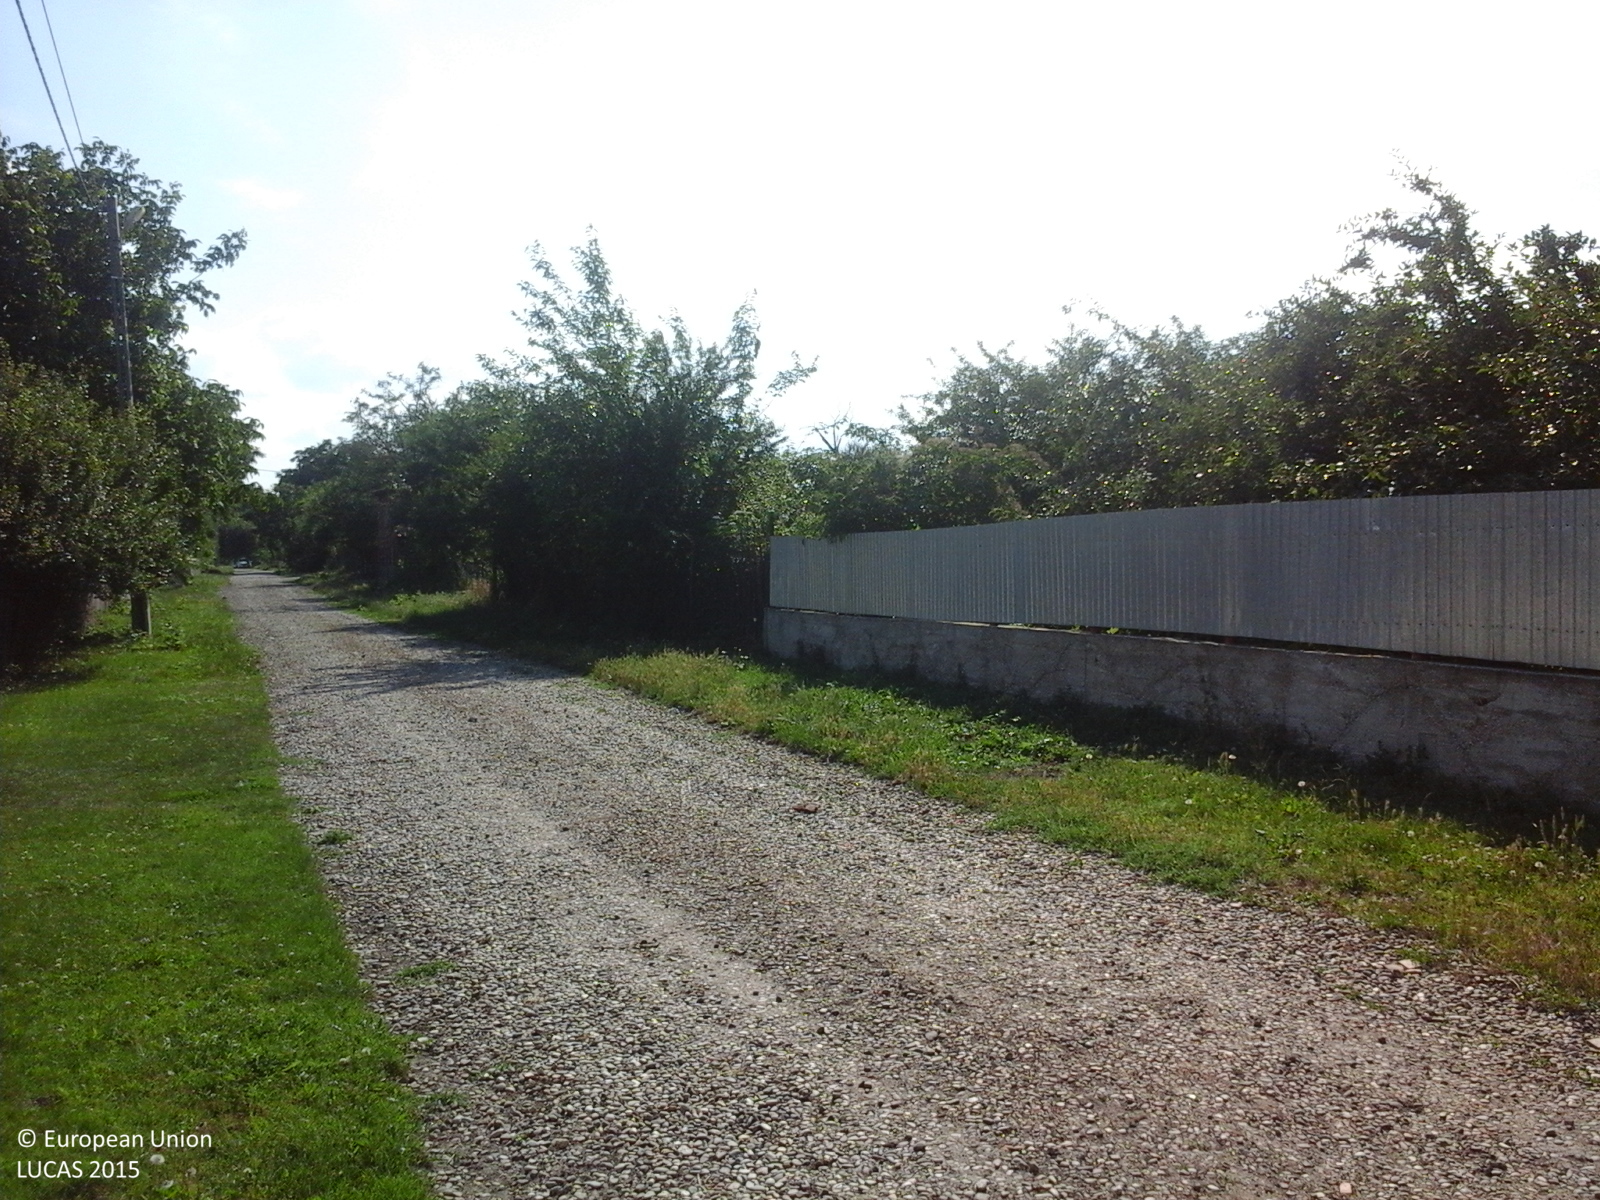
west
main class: Cropland
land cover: Apple fruit
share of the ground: 50 - 75 %
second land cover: Grassland without tree/shrub cover
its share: > 75 %
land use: Agriculture (excluding fallow land and kitchen gardens)
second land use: Residential
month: June
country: RO
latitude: 44.6061
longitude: 26.2251
